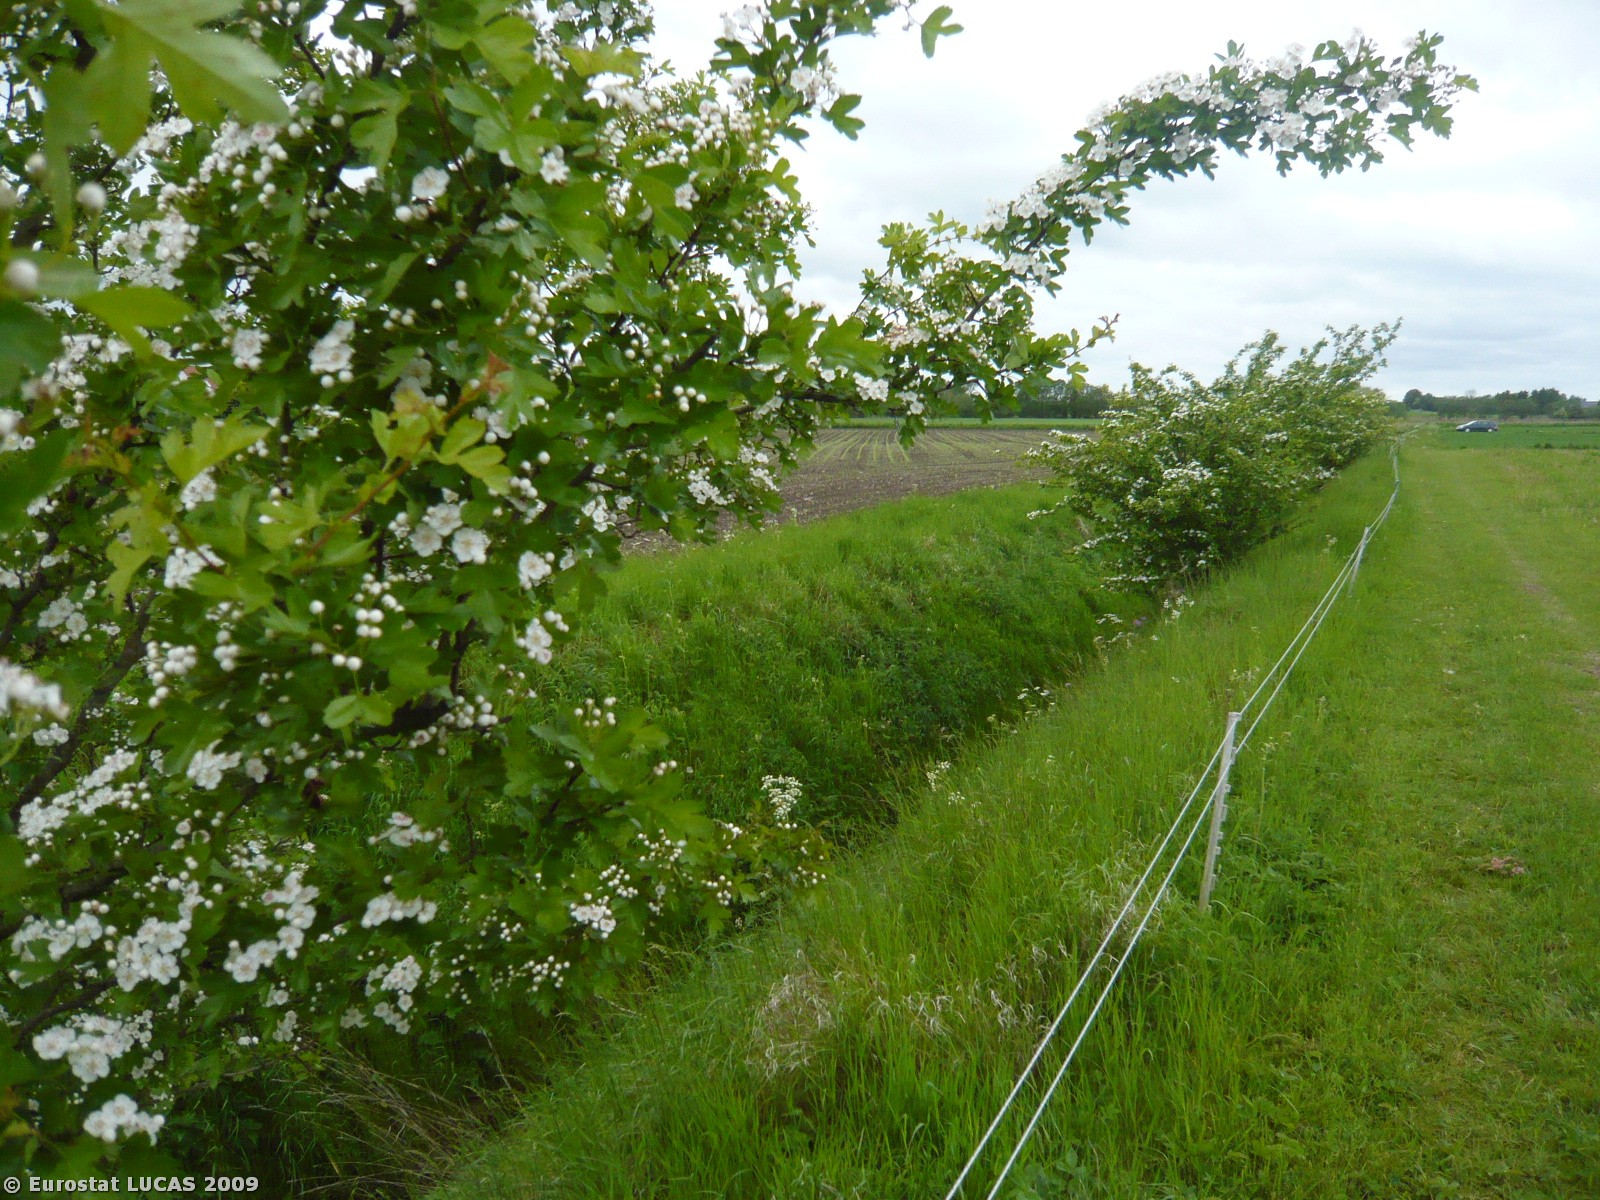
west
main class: Grassland
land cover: Grassland without tree/shrub cover
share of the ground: > 75 %
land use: Agriculture (excluding fallow land and kitchen gardens)
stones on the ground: < 10 %
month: May
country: DK
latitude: 55.4391
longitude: 11.7214
